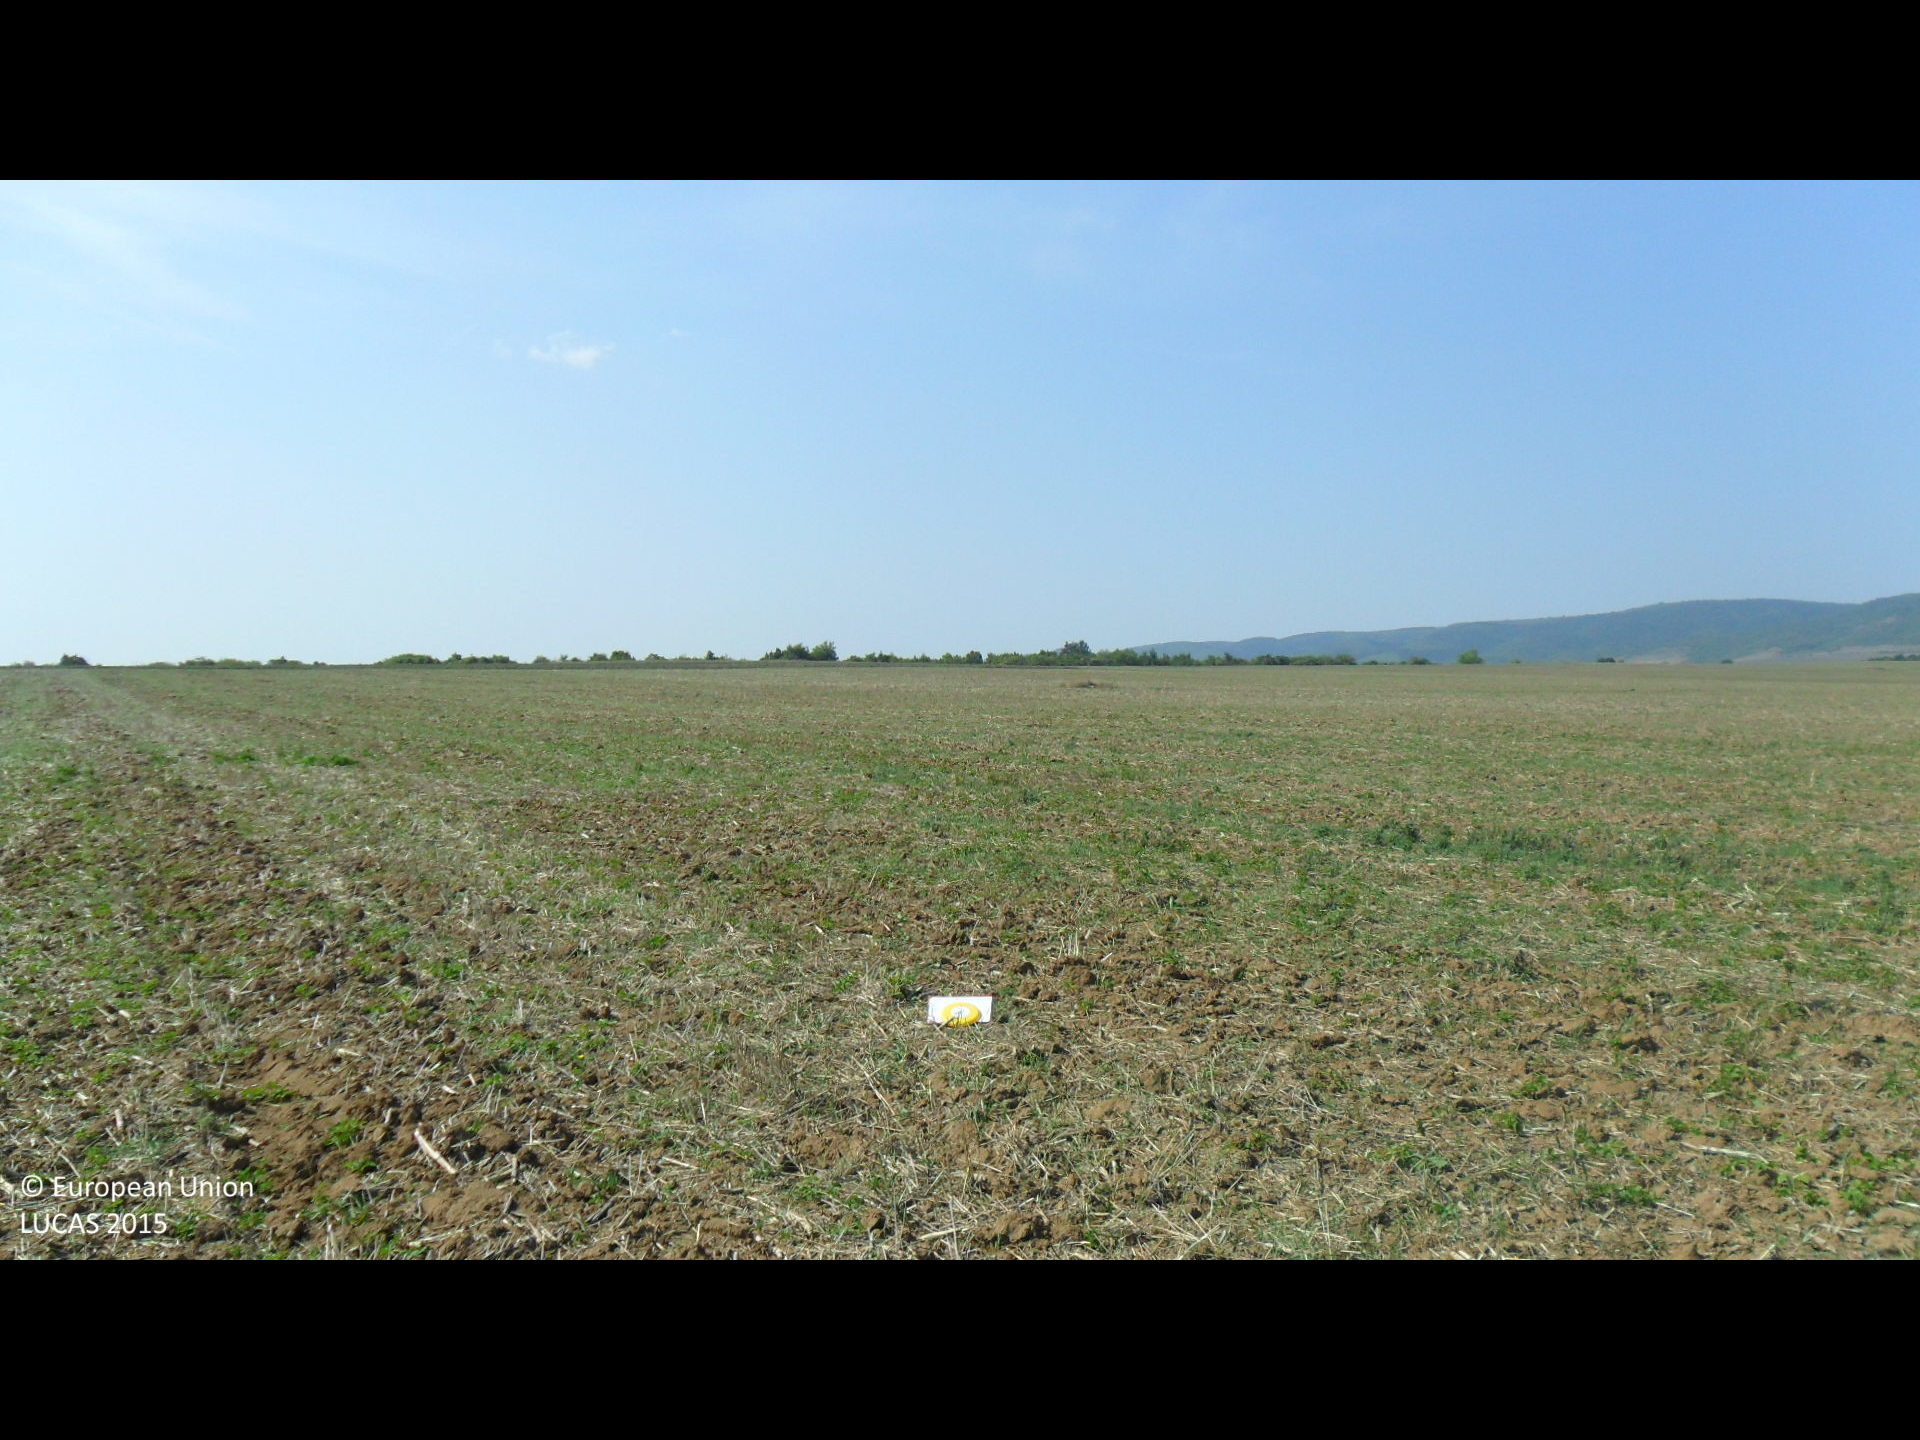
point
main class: Cropland
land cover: Common wheat
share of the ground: < 10 %
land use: Agriculture (excluding fallow land and kitchen gardens)
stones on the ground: < 10 %
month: September
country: BG
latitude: 43.0994
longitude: 26.6788
